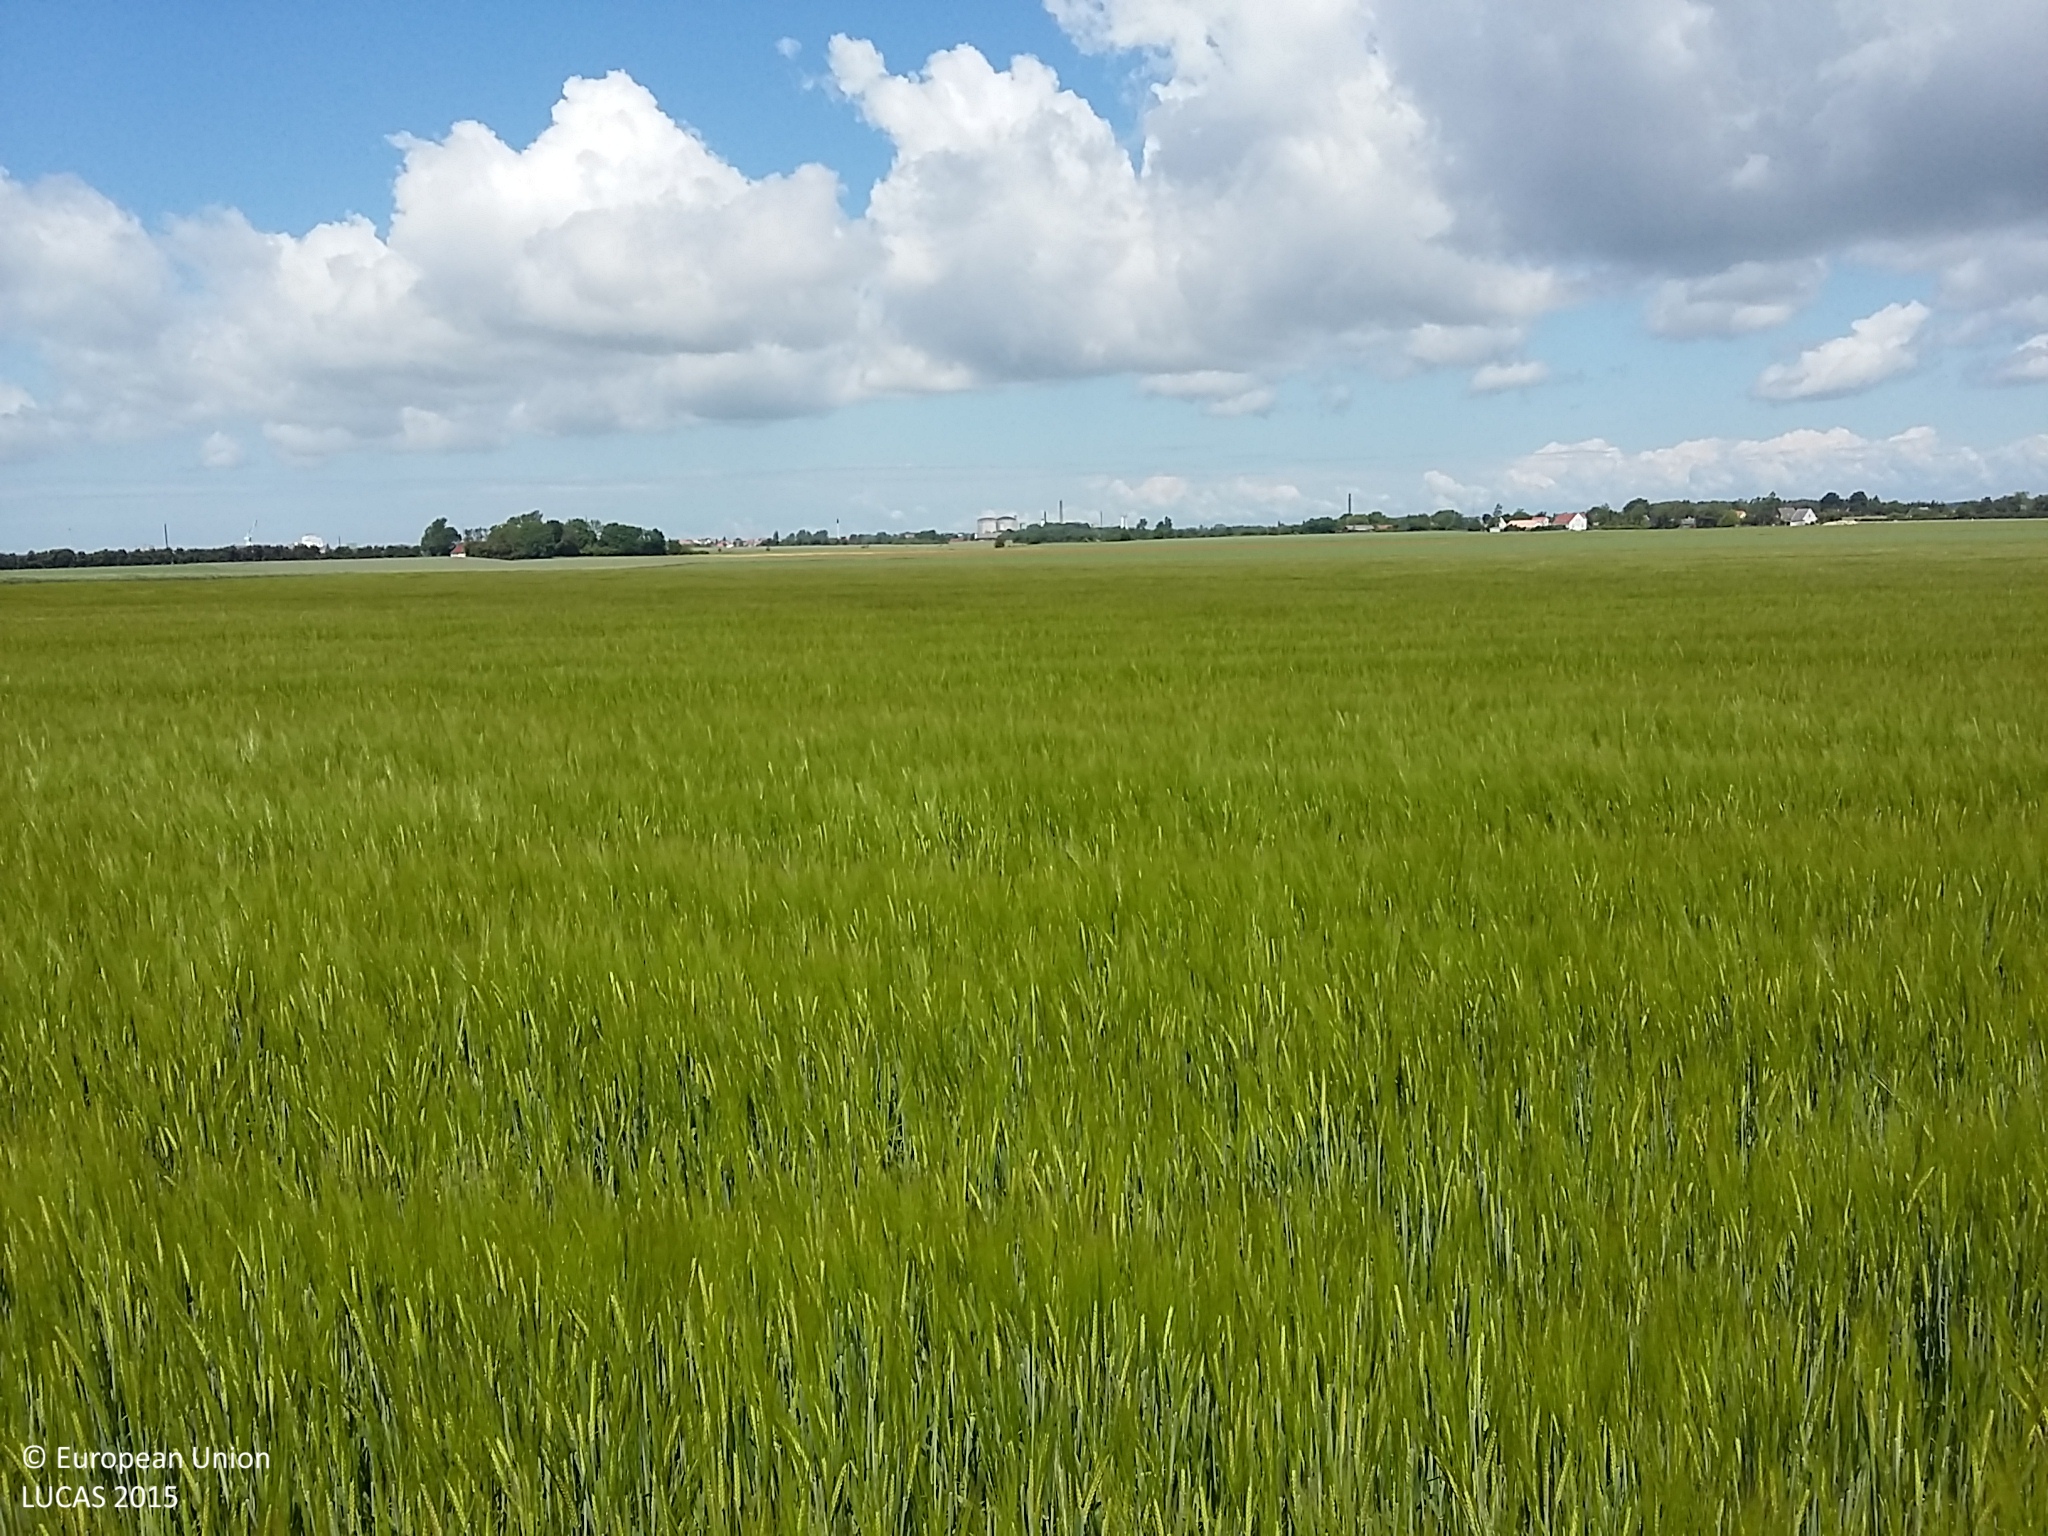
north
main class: Cropland
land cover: Barley
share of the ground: > 75 %
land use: Agriculture (excluding fallow land and kitchen gardens)
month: June
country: DK
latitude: 54.7986
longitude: 11.1347
